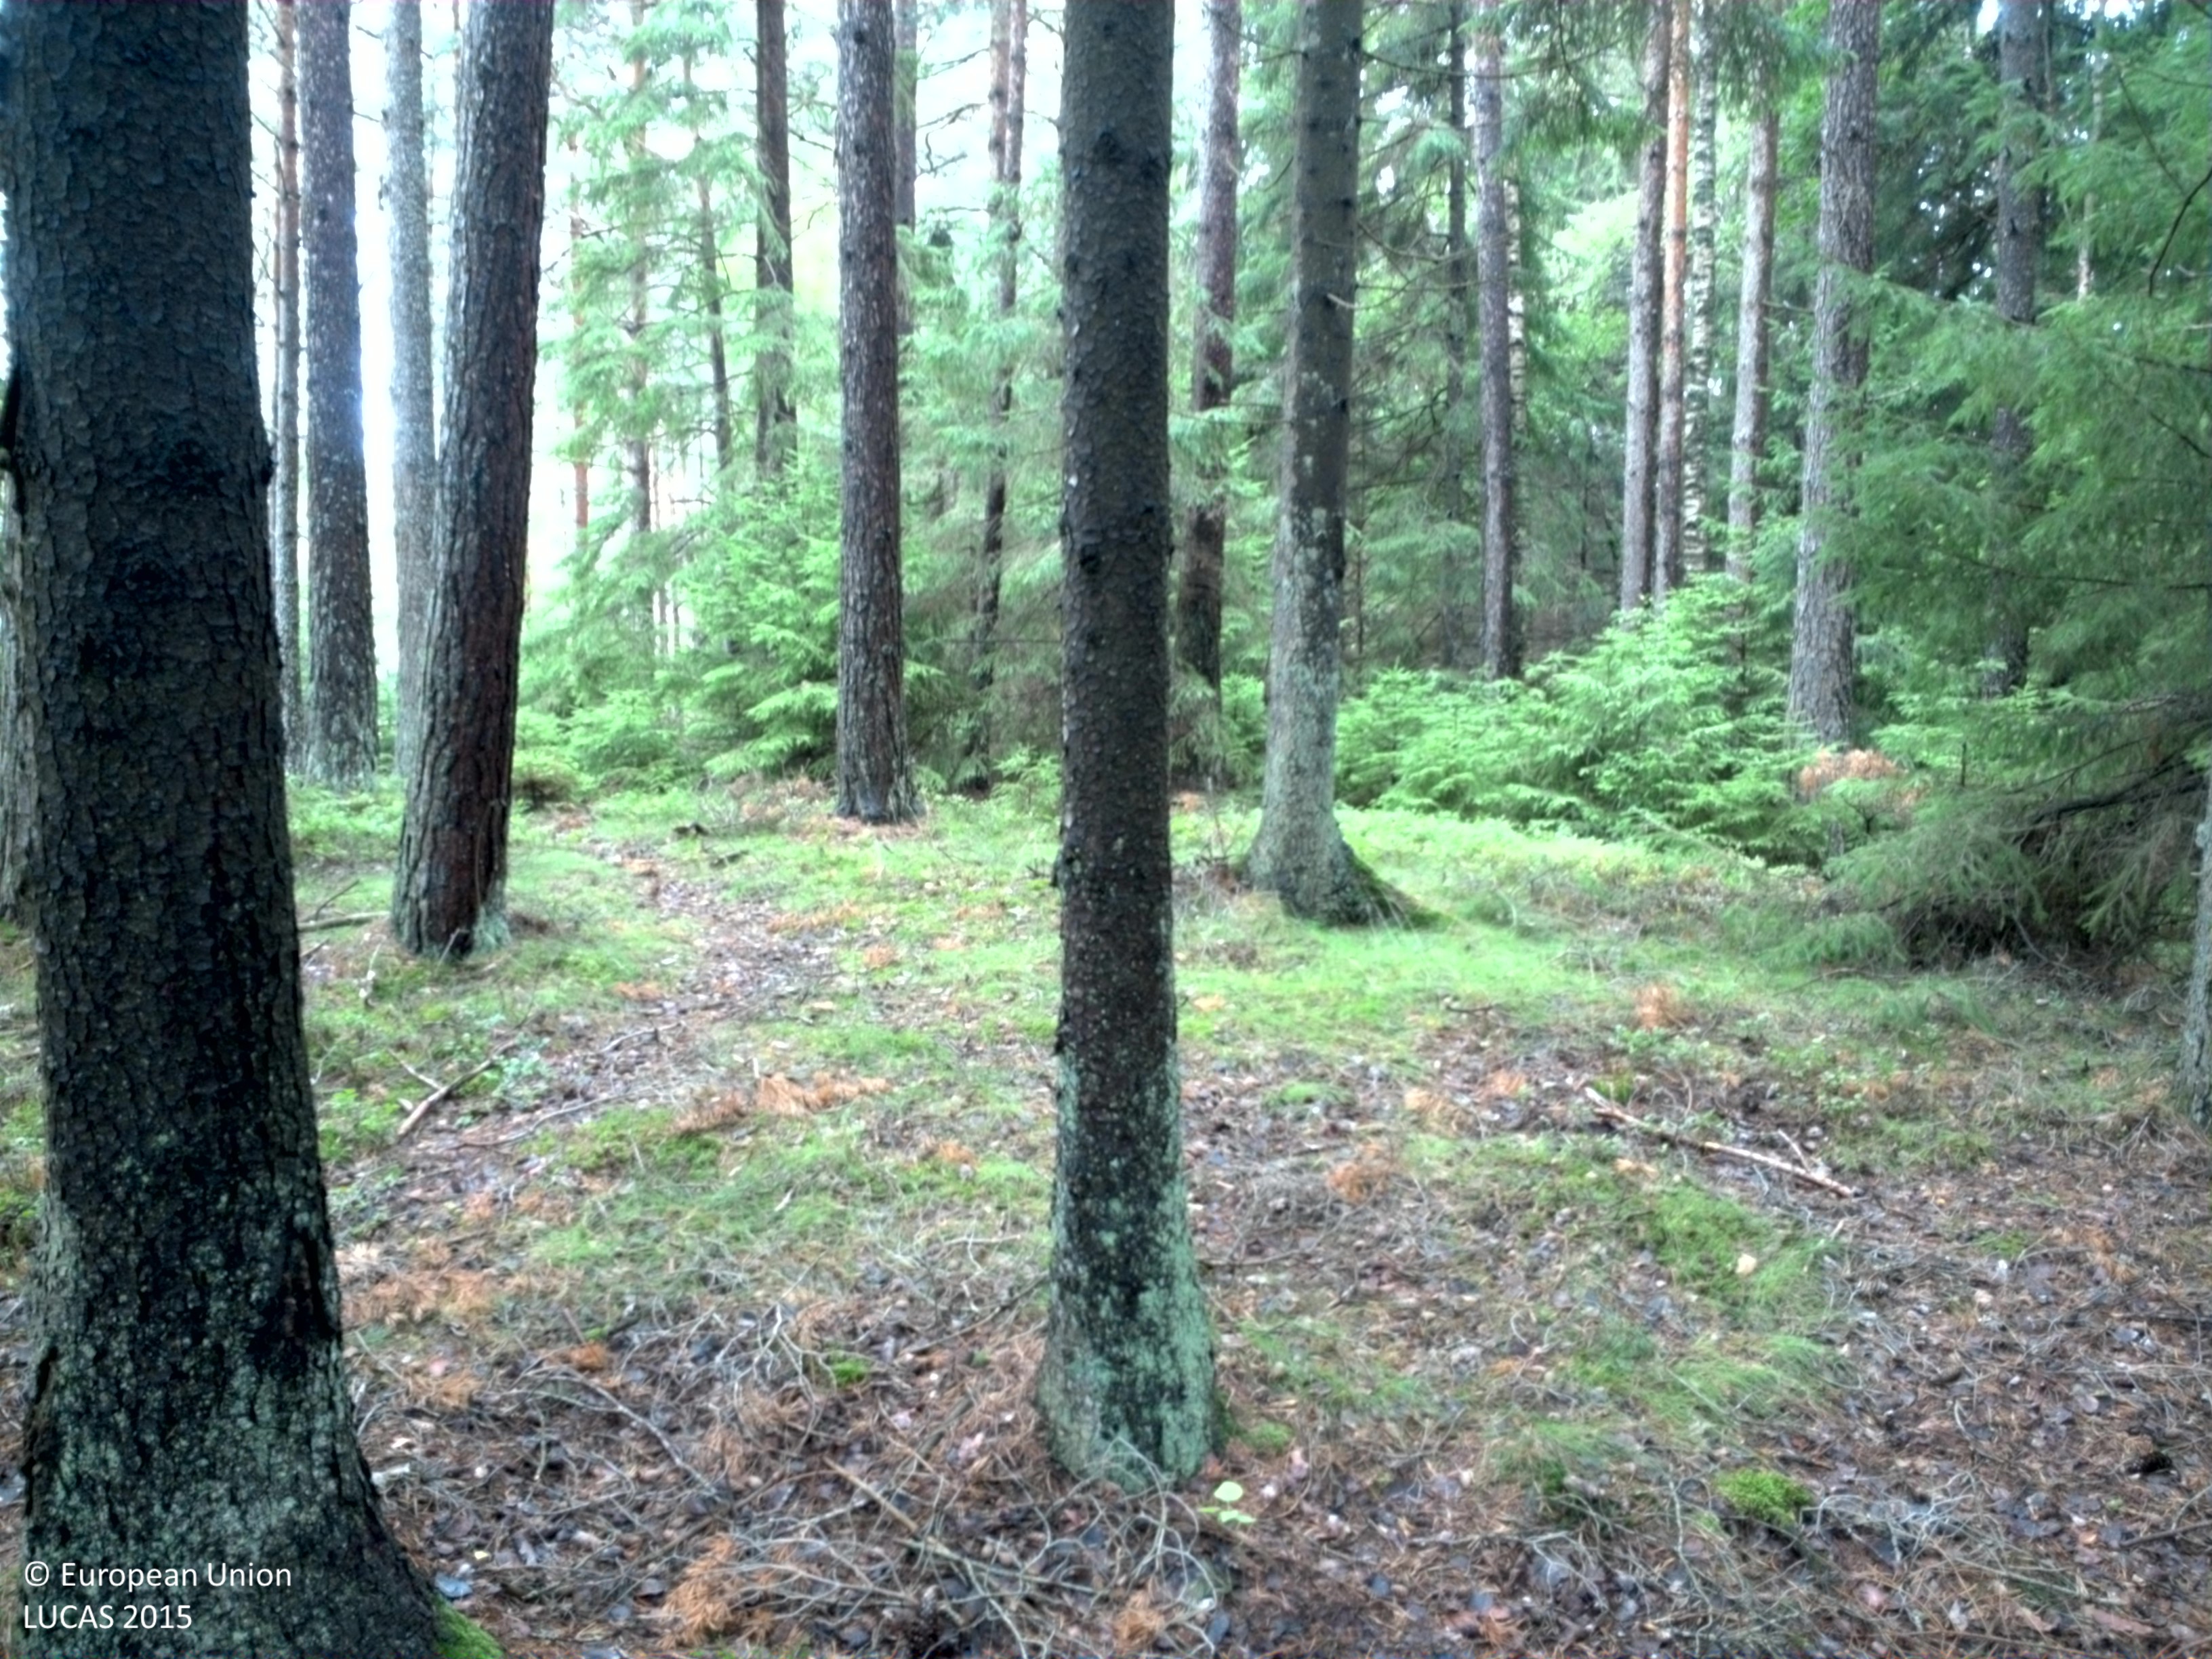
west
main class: Woodland
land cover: Spruce dominated coniferous woodland
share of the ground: > 75 %
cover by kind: coniferous forest trees 75 %, broadleaved forest trees 5 %, shrubs 5 %, herbaceous plants 5 %, lichens and mosses 5 %, unconsolidated bare surface 5 %
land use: Forestry
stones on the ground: < 10 %
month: July
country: SE
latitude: 58.4114
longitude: 13.3660
